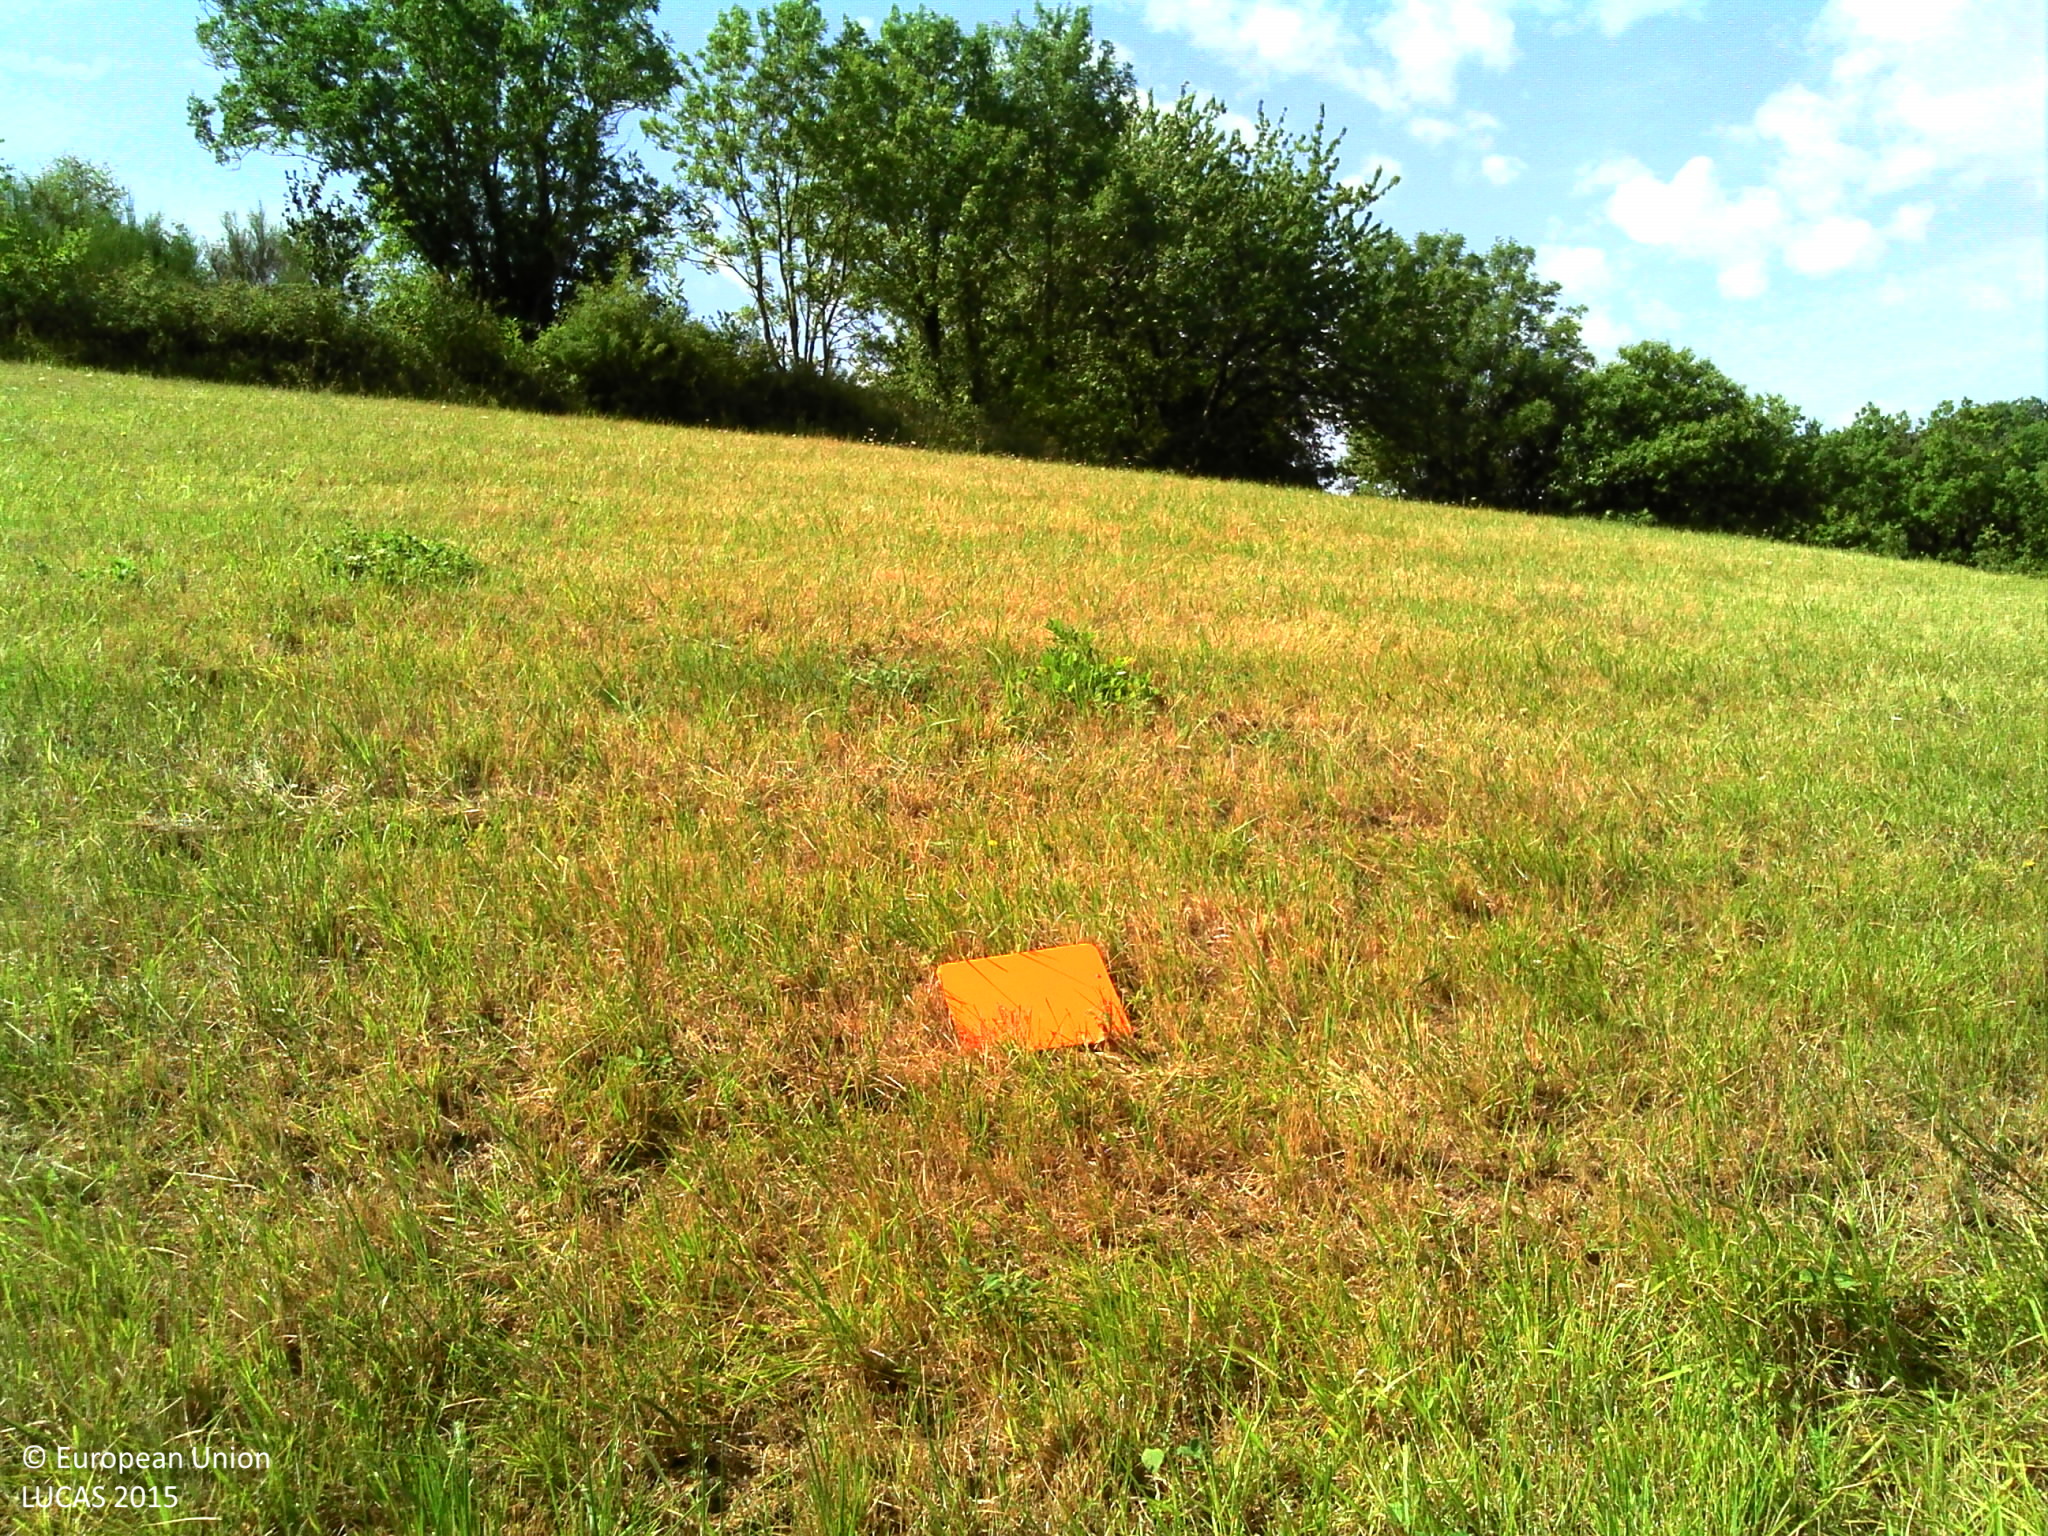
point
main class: Grassland
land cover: Grassland without tree/shrub cover
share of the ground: > 75 %
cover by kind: herbaceous plants 100 %
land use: Agriculture (excluding fallow land and kitchen gardens)
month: August
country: FR
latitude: 43.8445
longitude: 3.0289
